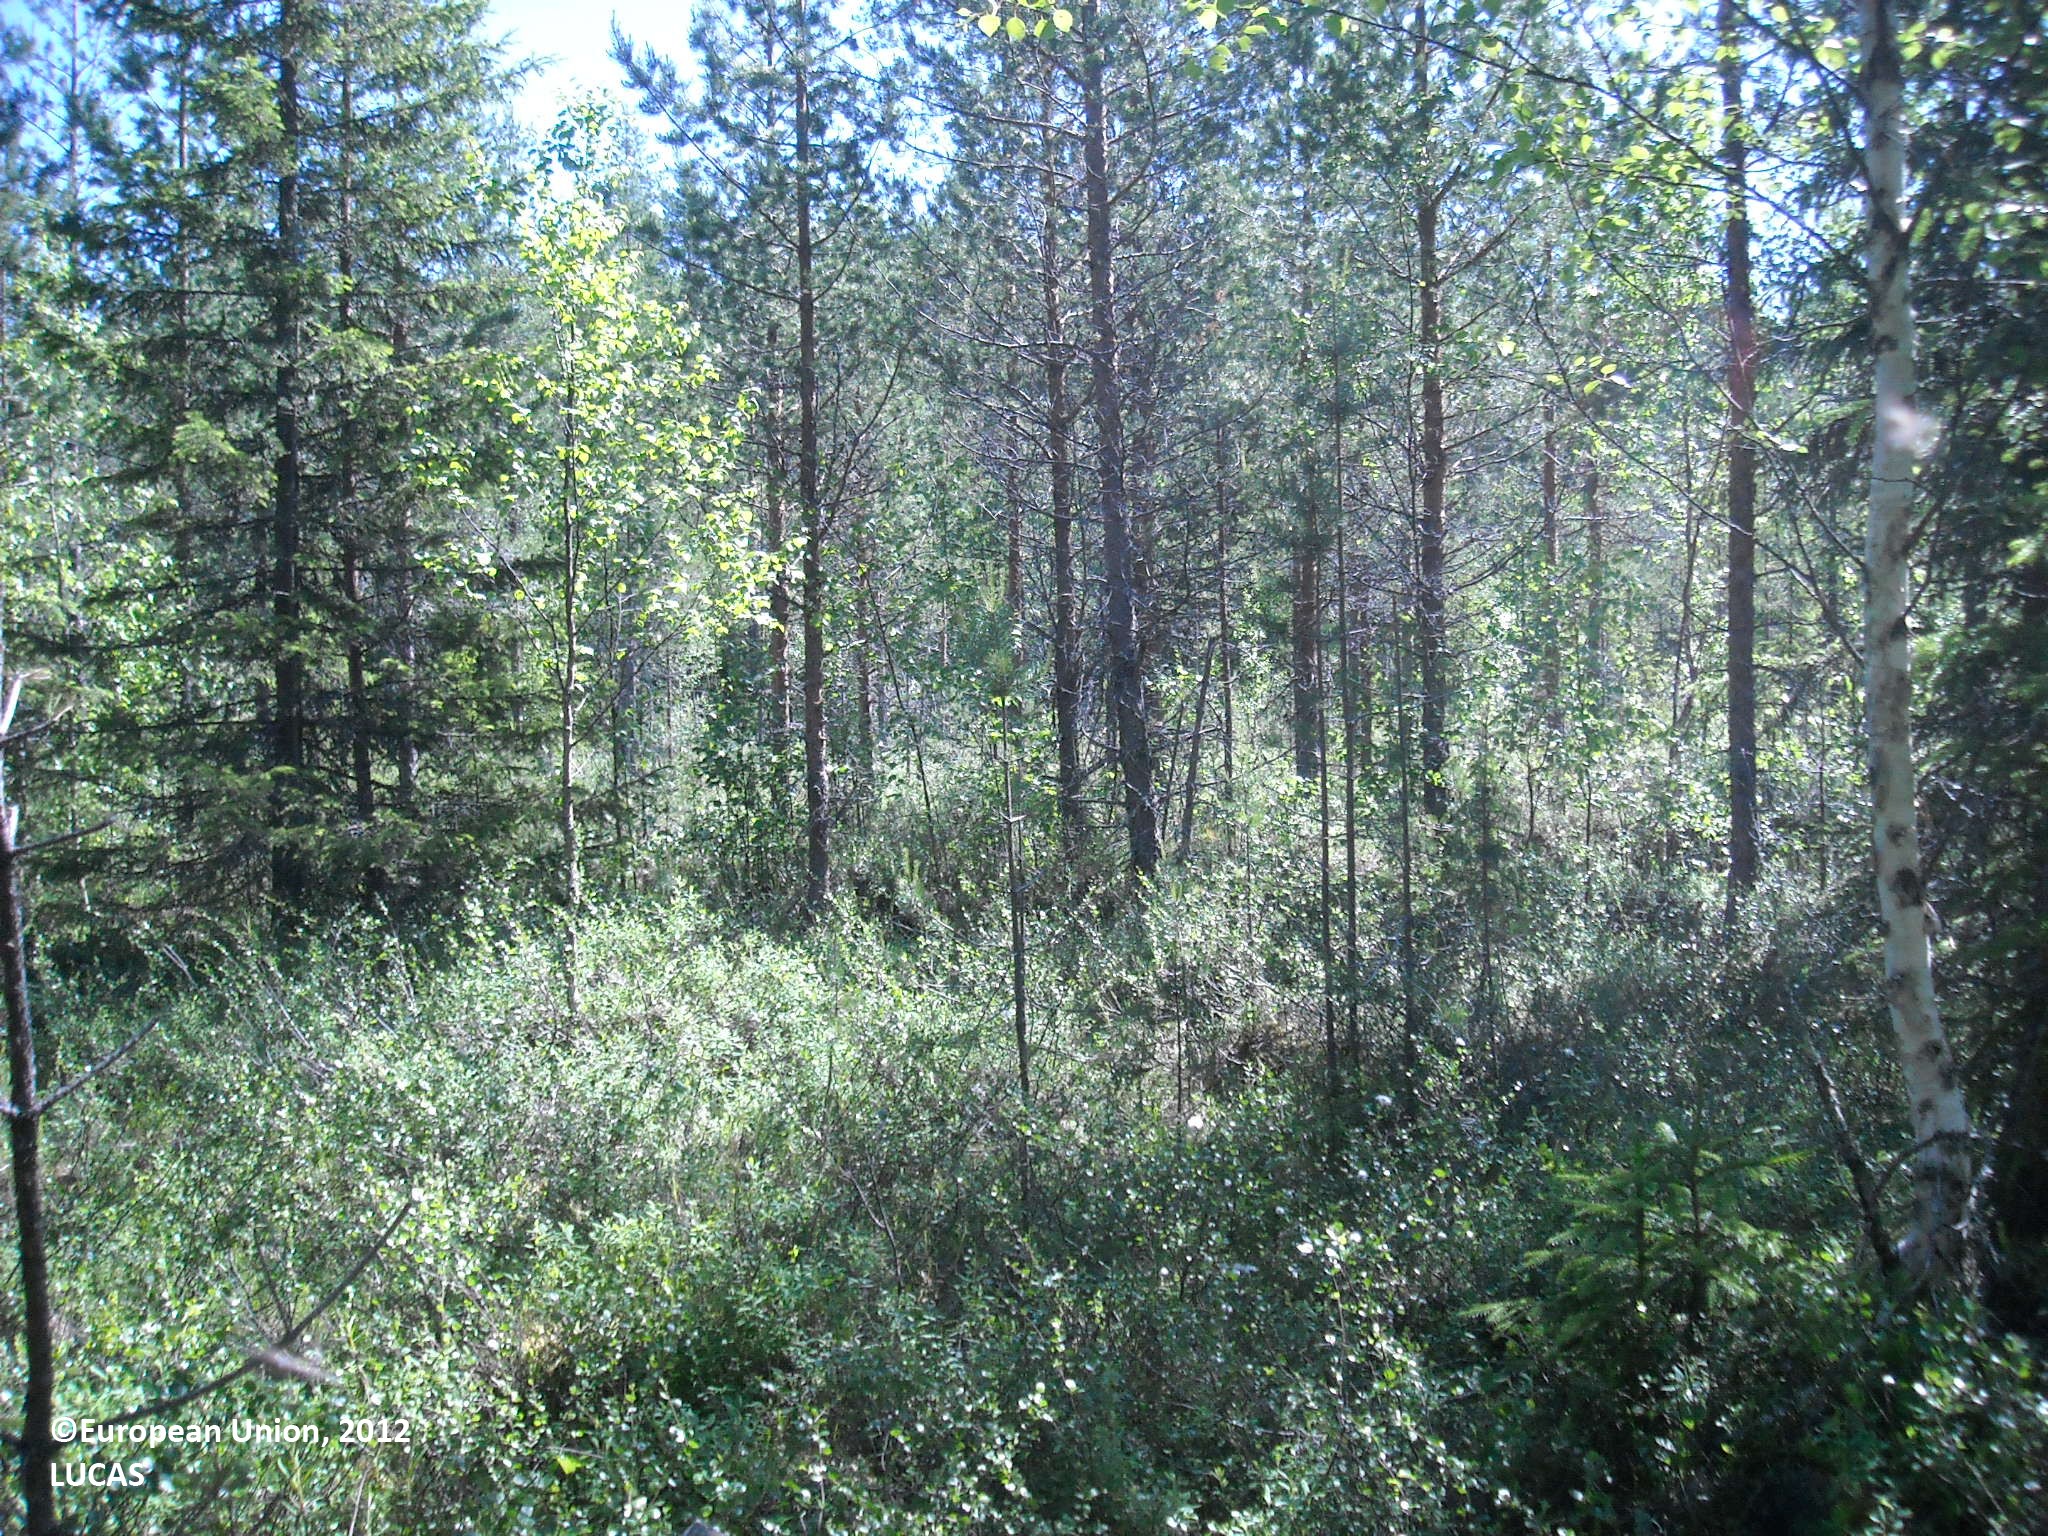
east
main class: Woodland
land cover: Other mixed woodland
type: boreal forest
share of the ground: > 75 %
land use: Forestry
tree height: > 5 m
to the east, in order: Other mixed woodland; Pine dominated coniferous woodland; Ditches and canals; Pine dominated coniferous woodland; Ditches and canals; Pine dominated coniferous woodland; Other coniferous woodland; Spruce dominated mixed woodland; Other mixed woodland; Other coniferous woodland
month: July
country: FI
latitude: 64.9130
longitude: 27.4044
